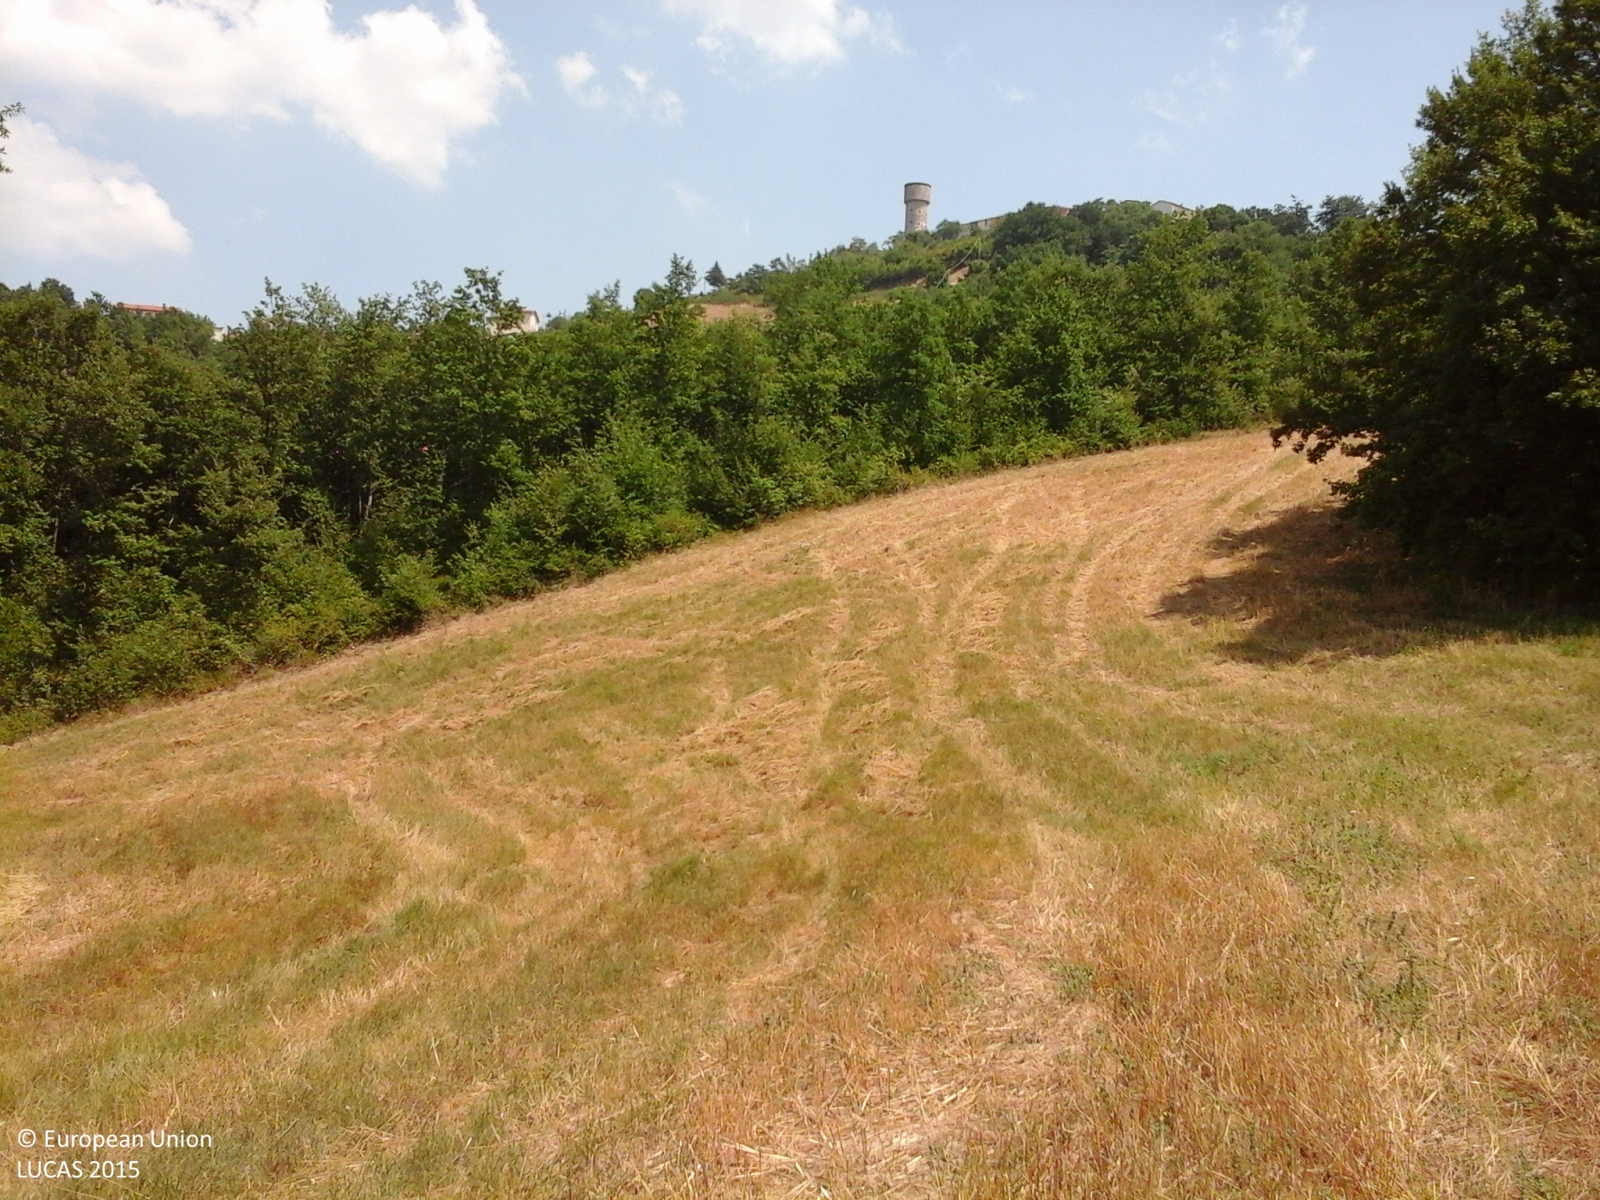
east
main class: Cropland
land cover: Common wheat
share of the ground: > 75 %
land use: Agriculture (excluding fallow land and kitchen gardens)
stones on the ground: < 10 %
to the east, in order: Common wheat; Broadleaved woodland; Artificial constructions in urban areas
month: August
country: IT
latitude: 41.6319
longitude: 14.4858
